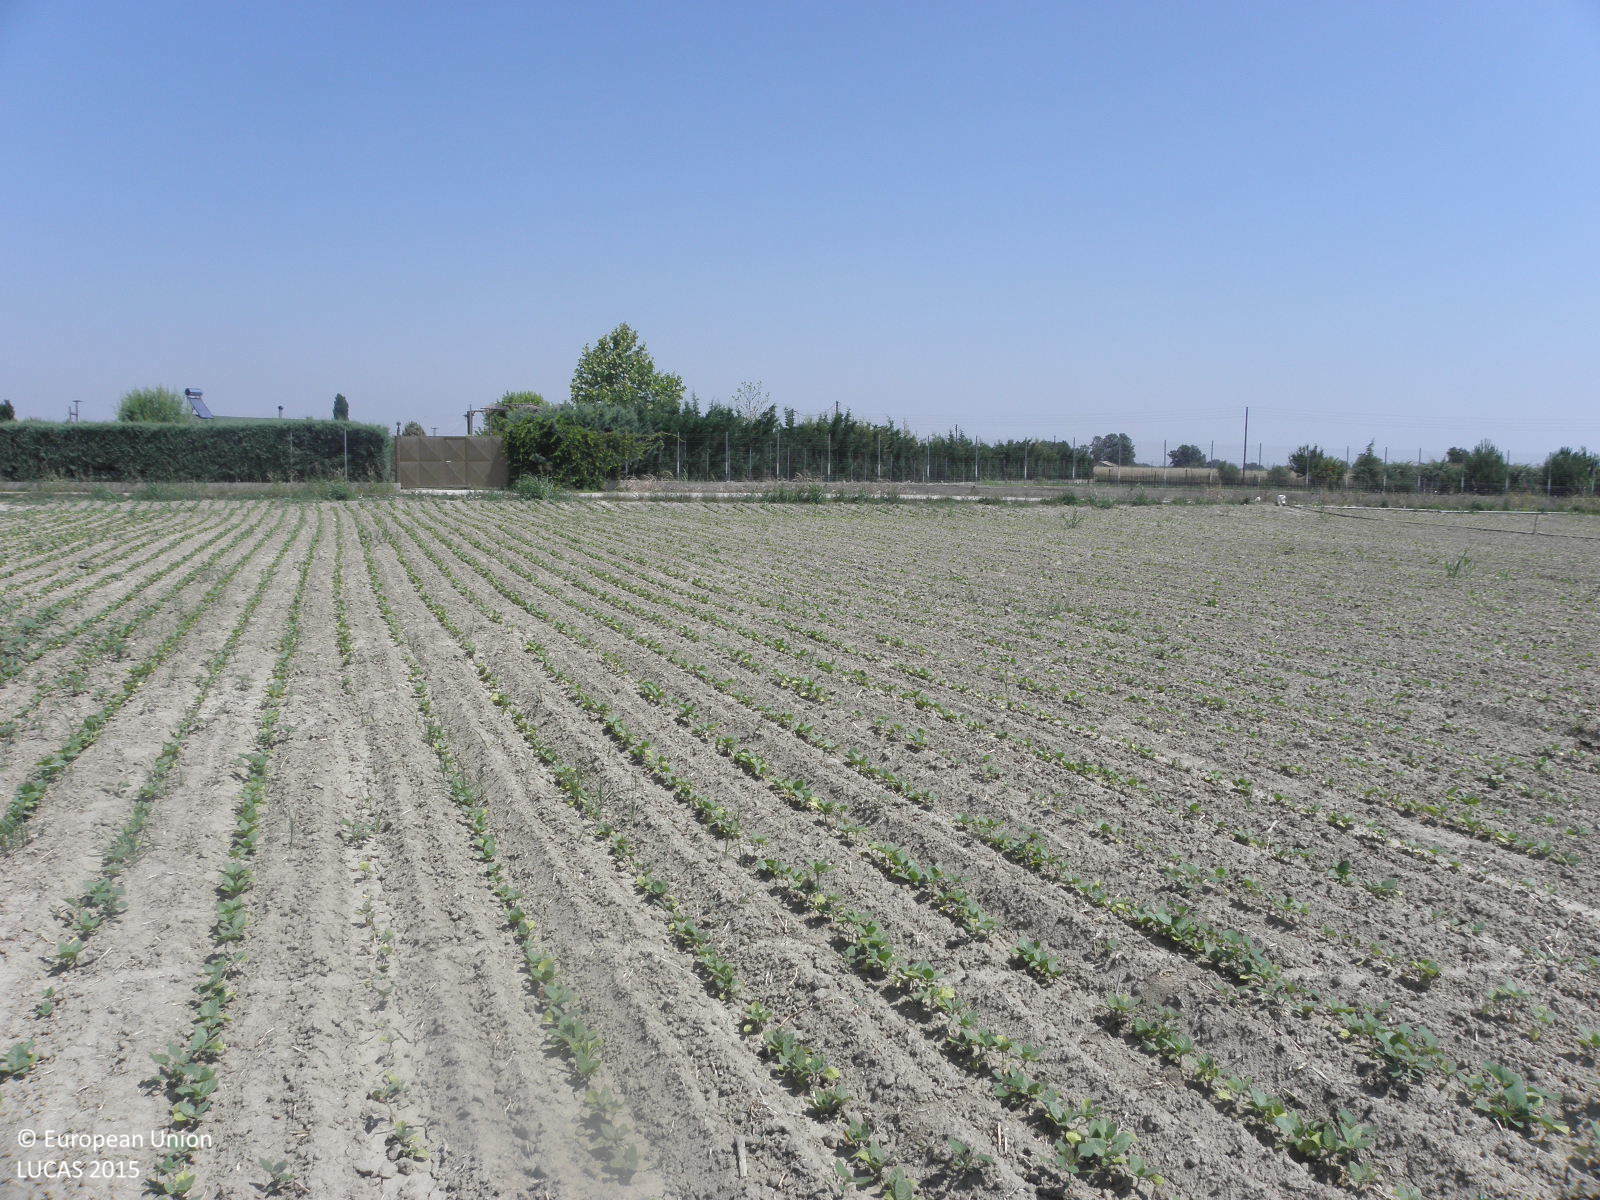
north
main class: Cropland
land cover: Tobacco
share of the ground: < 10 %
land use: Agriculture (excluding fallow land and kitchen gardens)
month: June
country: GR
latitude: 40.2127
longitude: 22.5111
